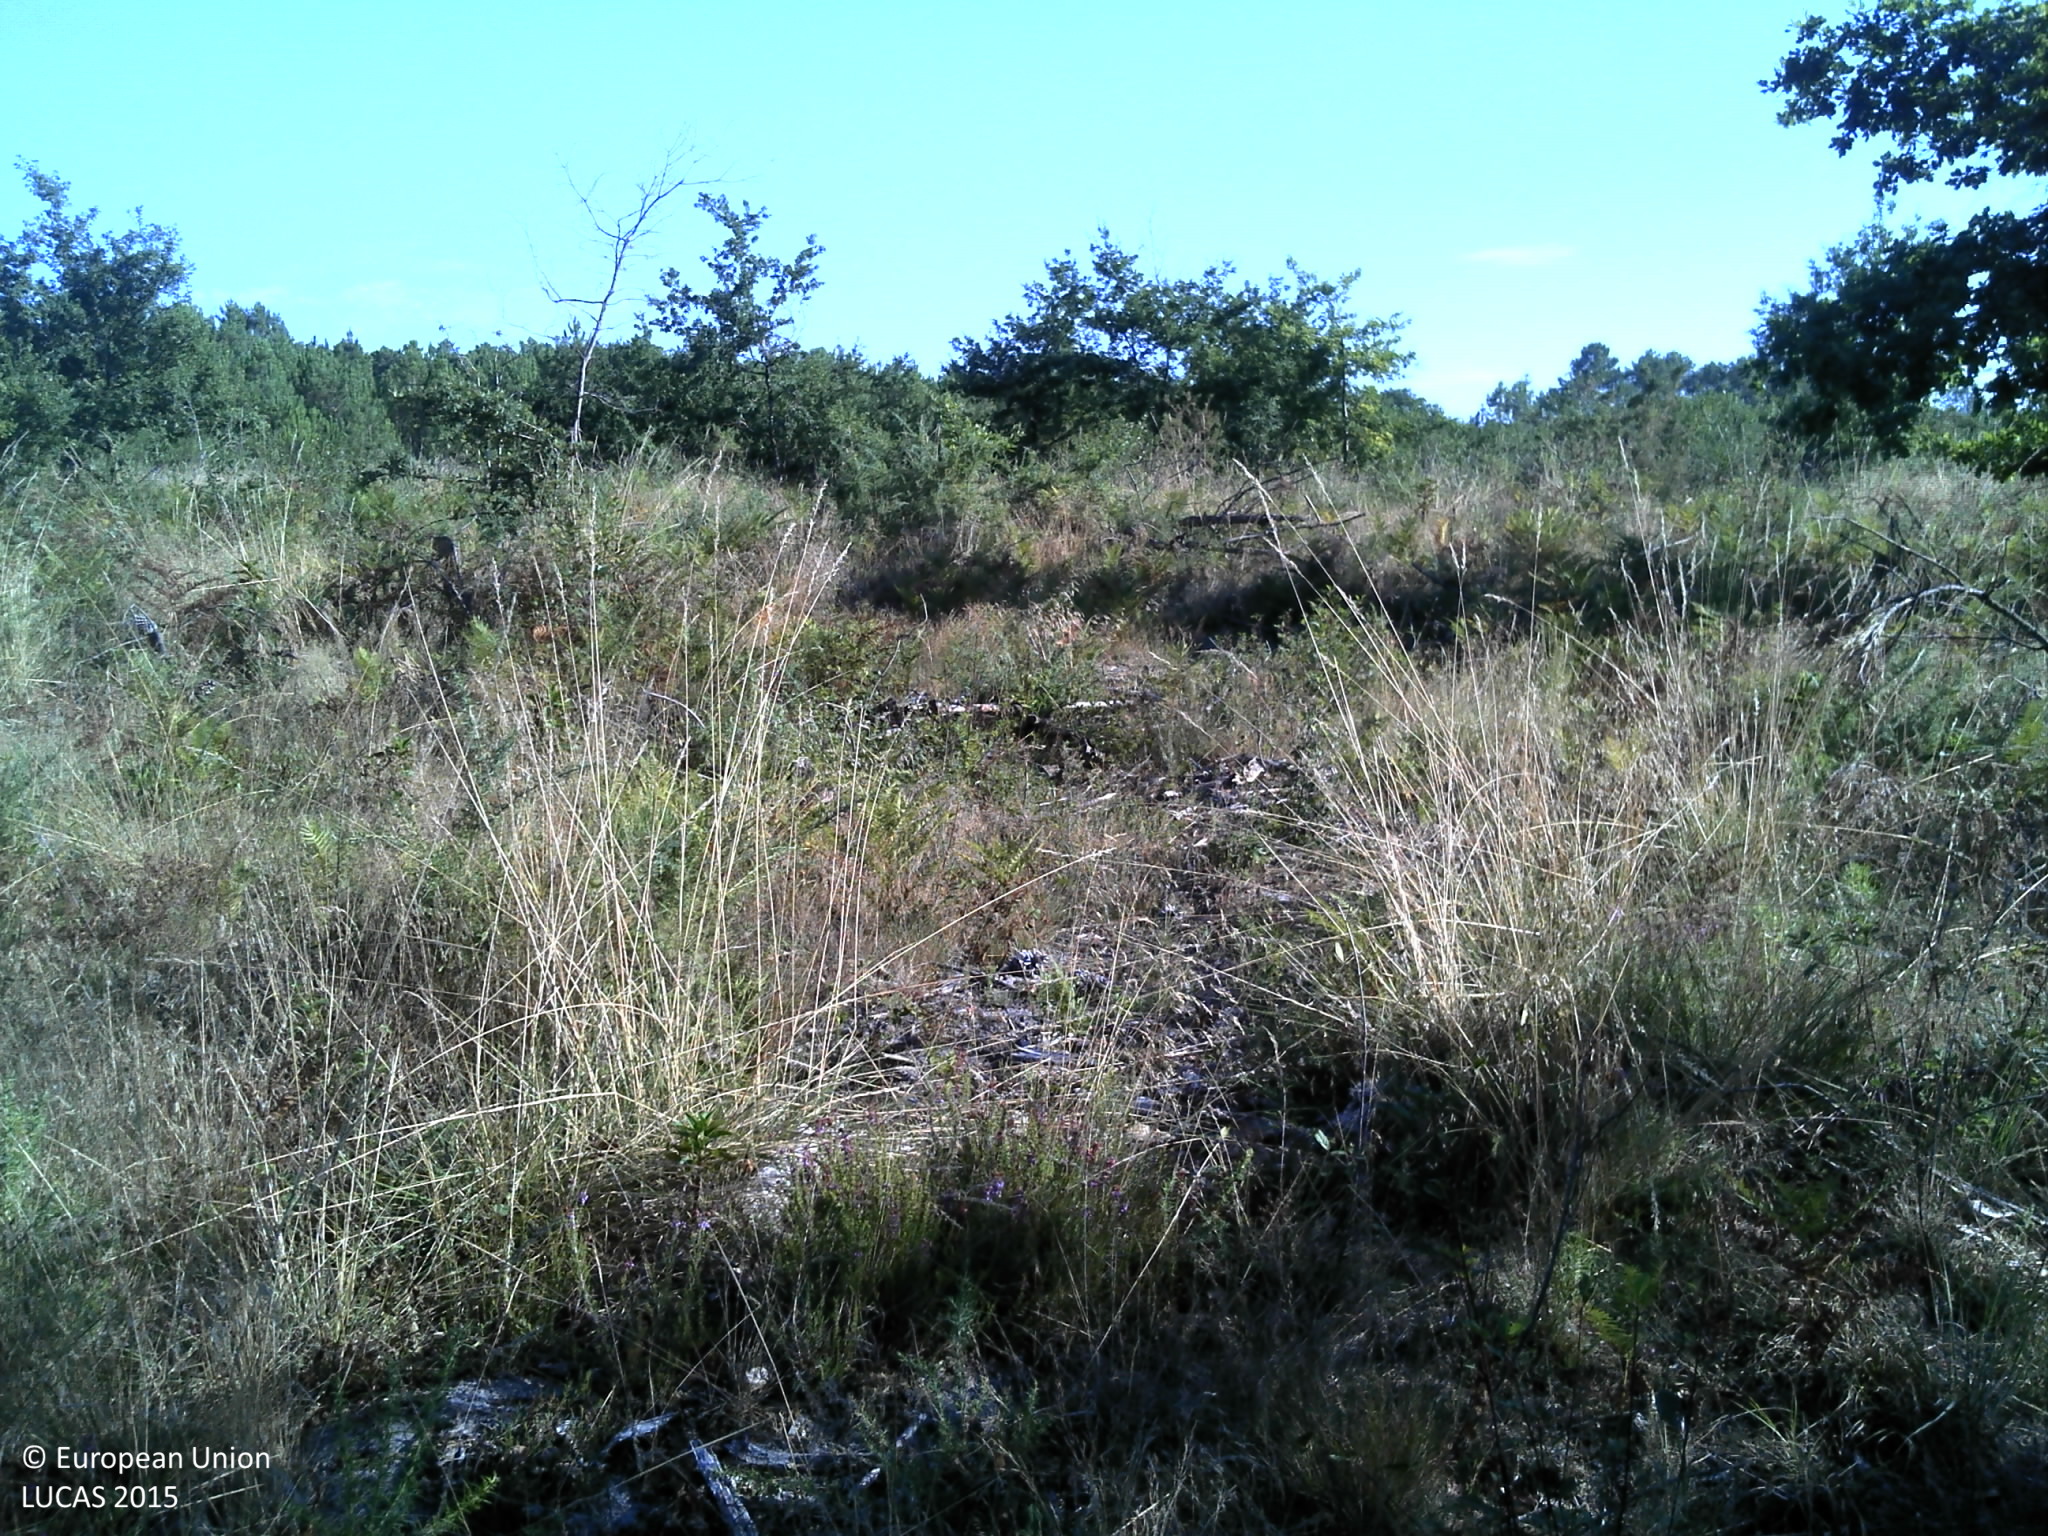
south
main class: Woodland
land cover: Pine dominated mixed woodland
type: coniferous forest of the mediterranean region
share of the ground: 50 - 75 %
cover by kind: broadleaved forest trees 50 %, coniferous forest trees 25 %, shrubs 15 %, herbaceous plants 5 %, lichens and mosses 5 %
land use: Forestry
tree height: < 5 m
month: August
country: FR
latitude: 44.5051
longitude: -0.6964
